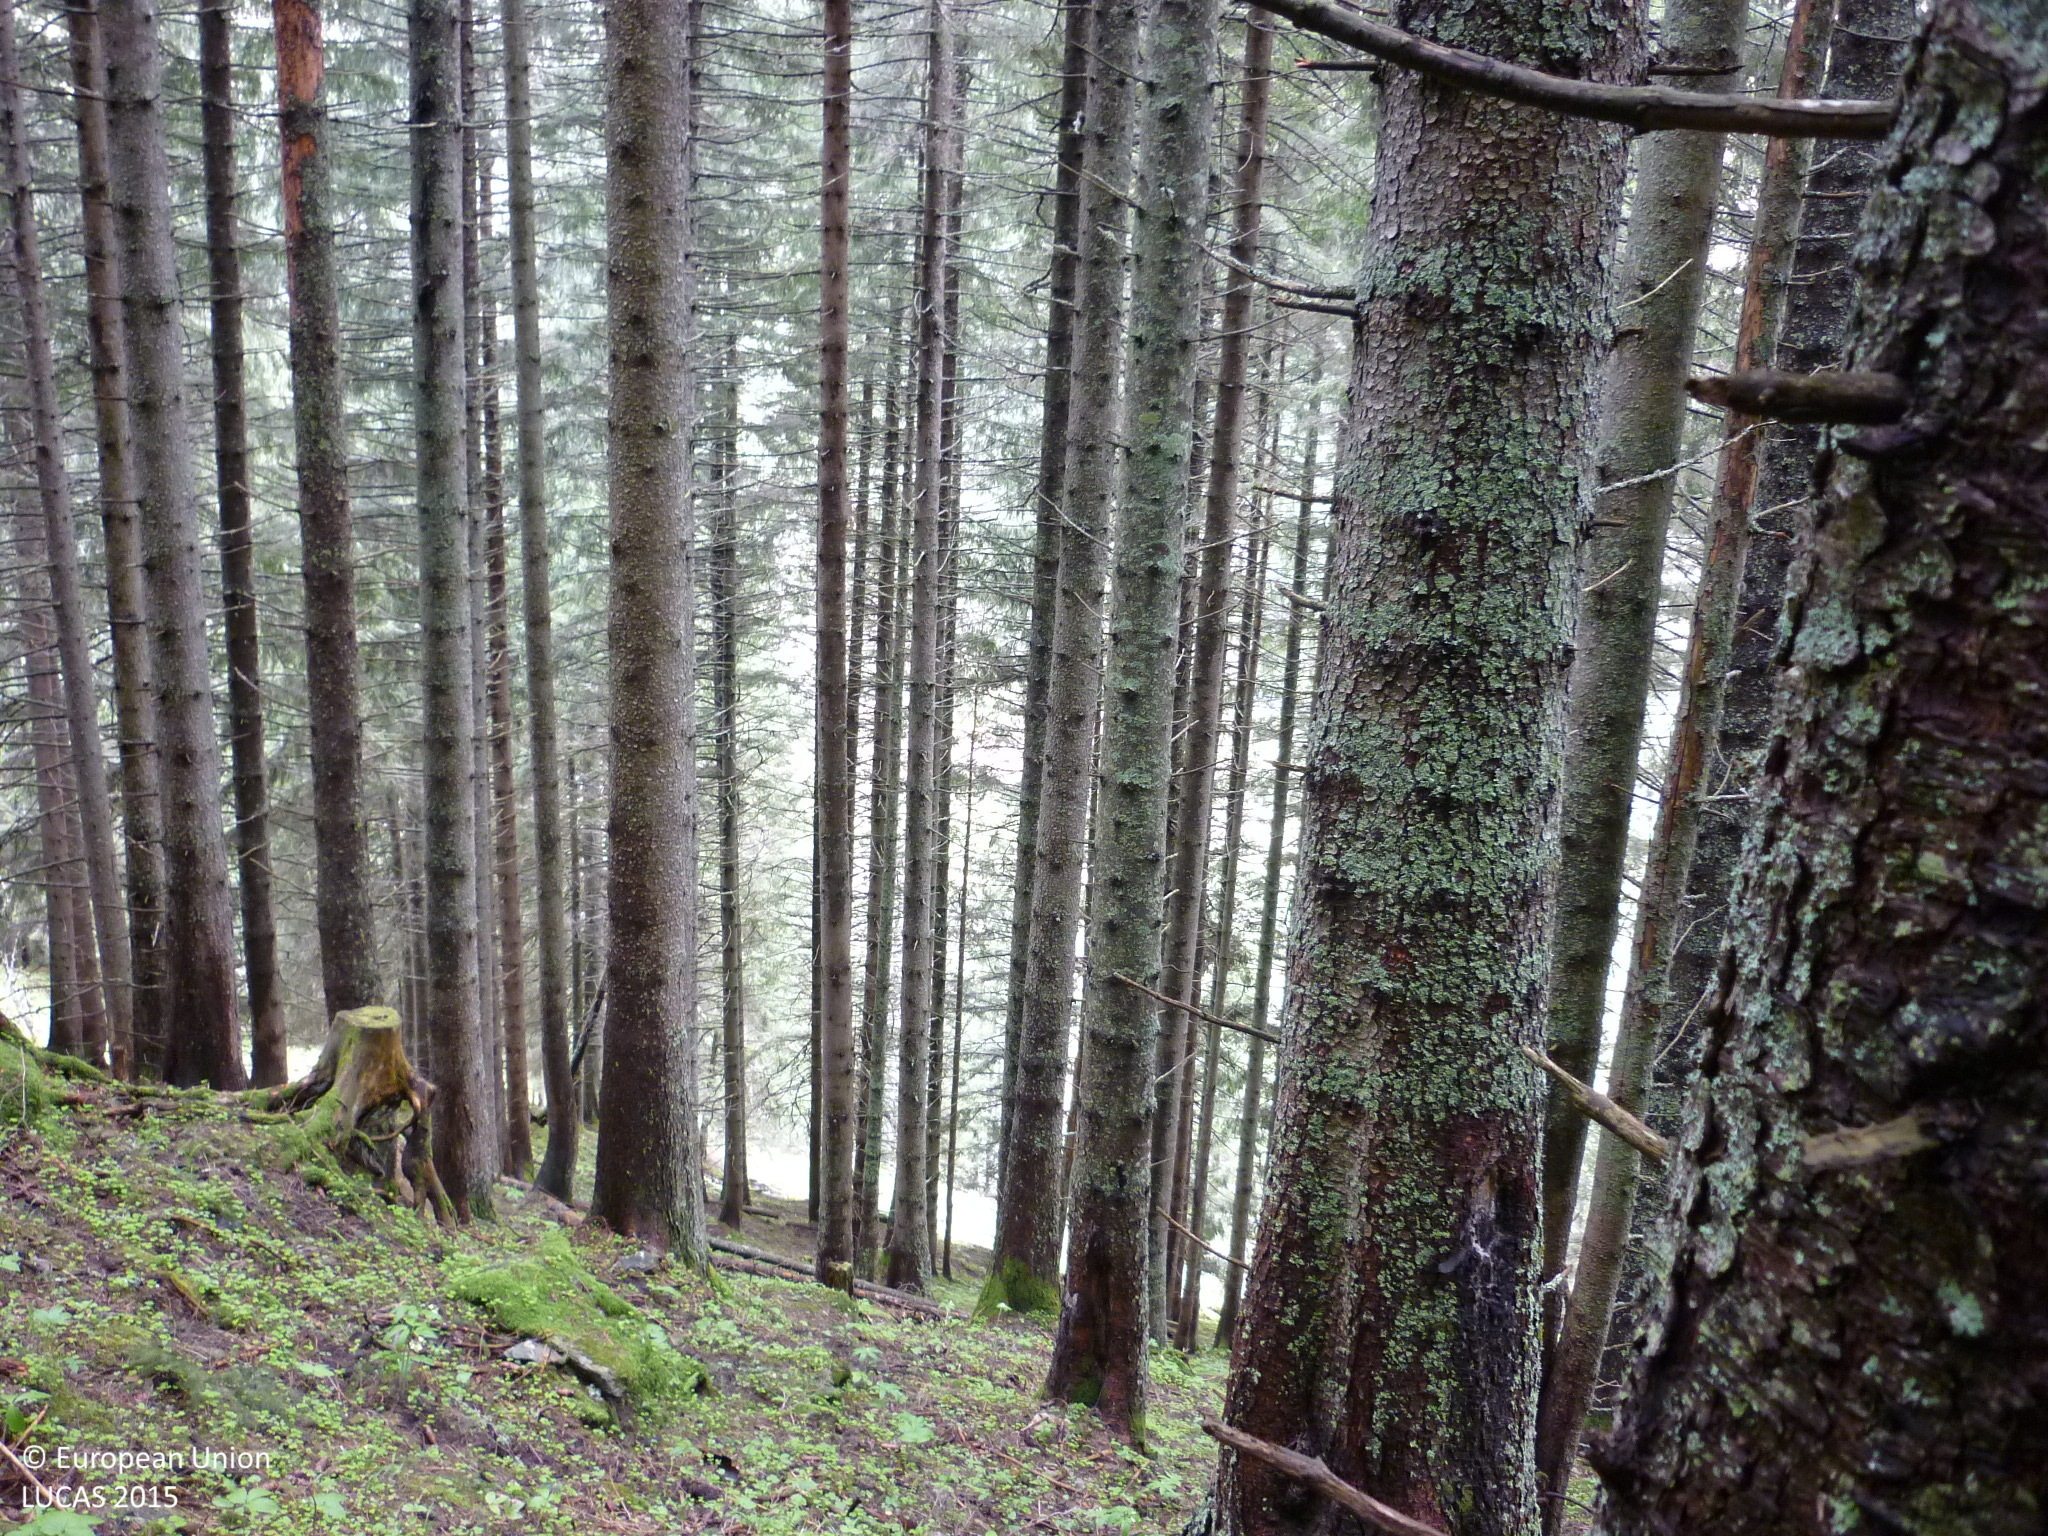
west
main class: Woodland
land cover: Spruce dominated coniferous woodland
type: alpine coniferous forest
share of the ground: > 75 %
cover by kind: coniferous forest trees 85 %, herbaceous plants 5 %, lichens and mosses 5 %, unconsolidated bare surface 5 %
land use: Forestry
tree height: > 5 m
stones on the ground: 10 - 25 %
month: May
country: AT
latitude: 47.3029
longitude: 14.0323
